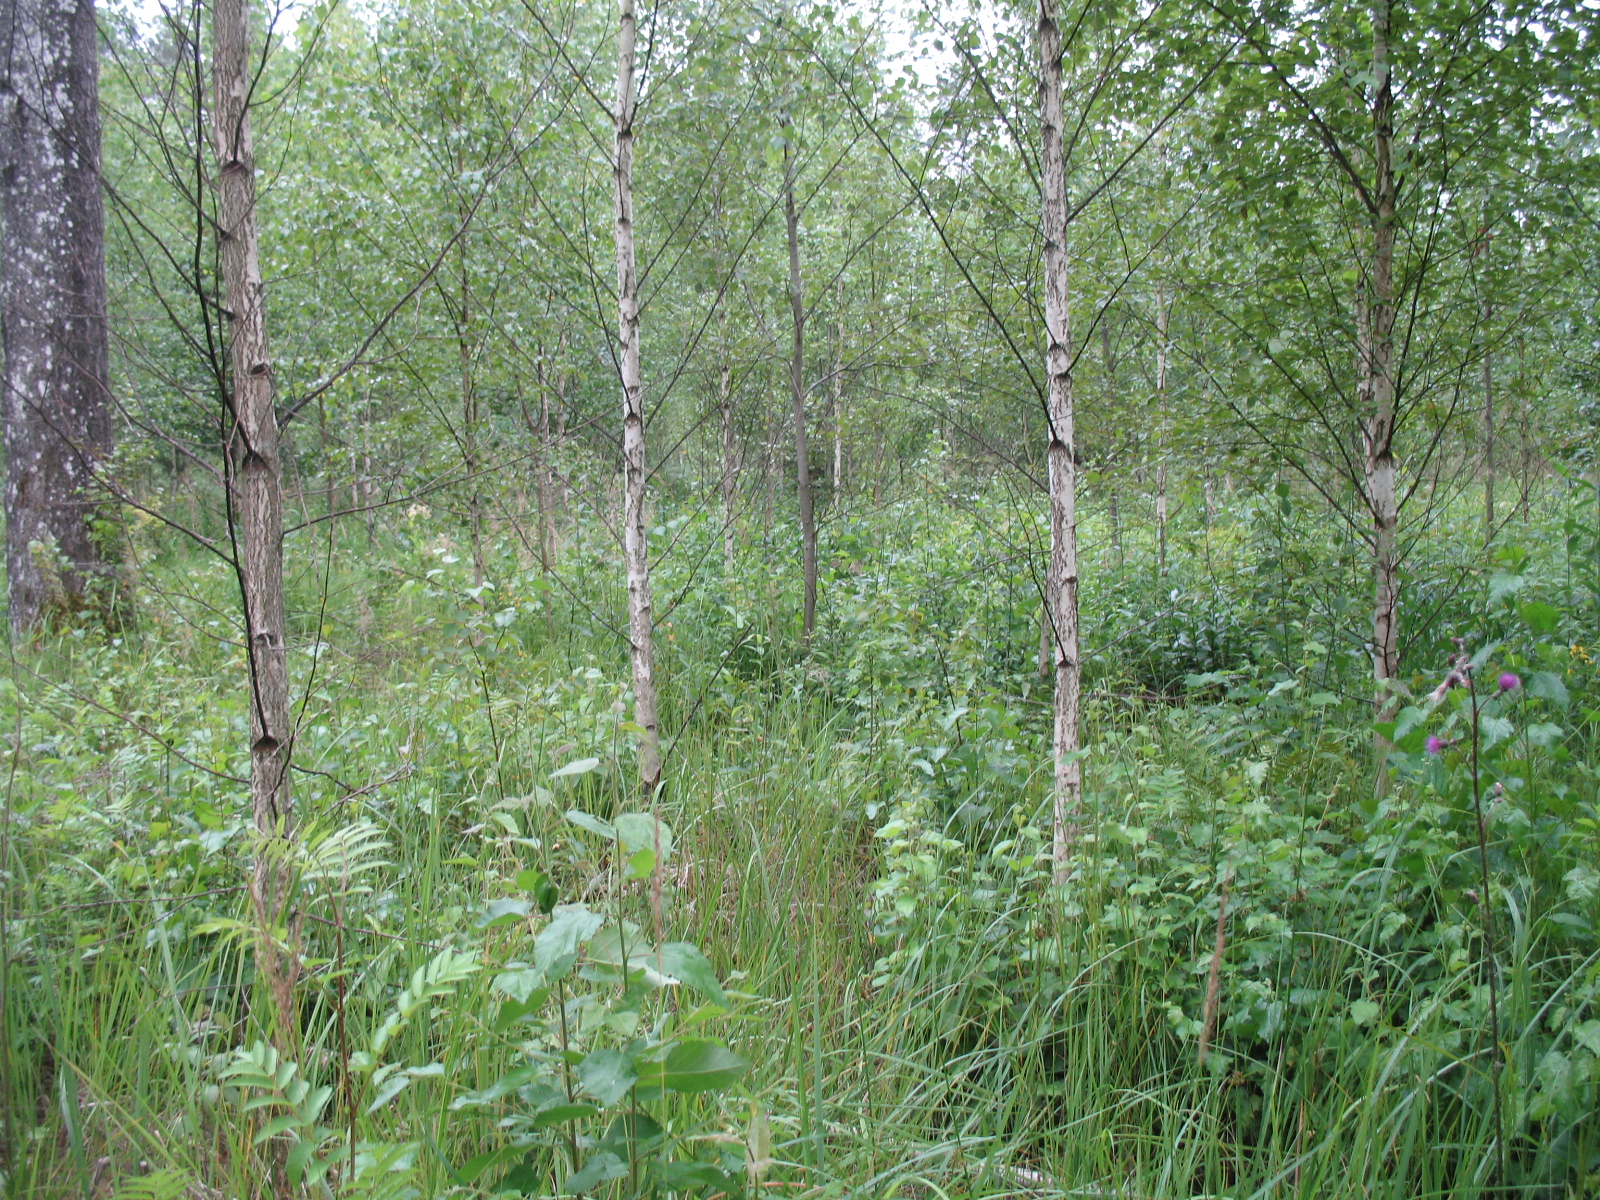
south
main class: Woodland
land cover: Broadleaved woodland
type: non-riverine alder, birch or aspen forest
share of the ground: 50 - 75 %
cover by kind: broadleaved forest trees 60 %, herbaceous plants 40 %
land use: Forestry
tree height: > 5 m
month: July
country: LV
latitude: 56.3387
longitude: 25.0404
